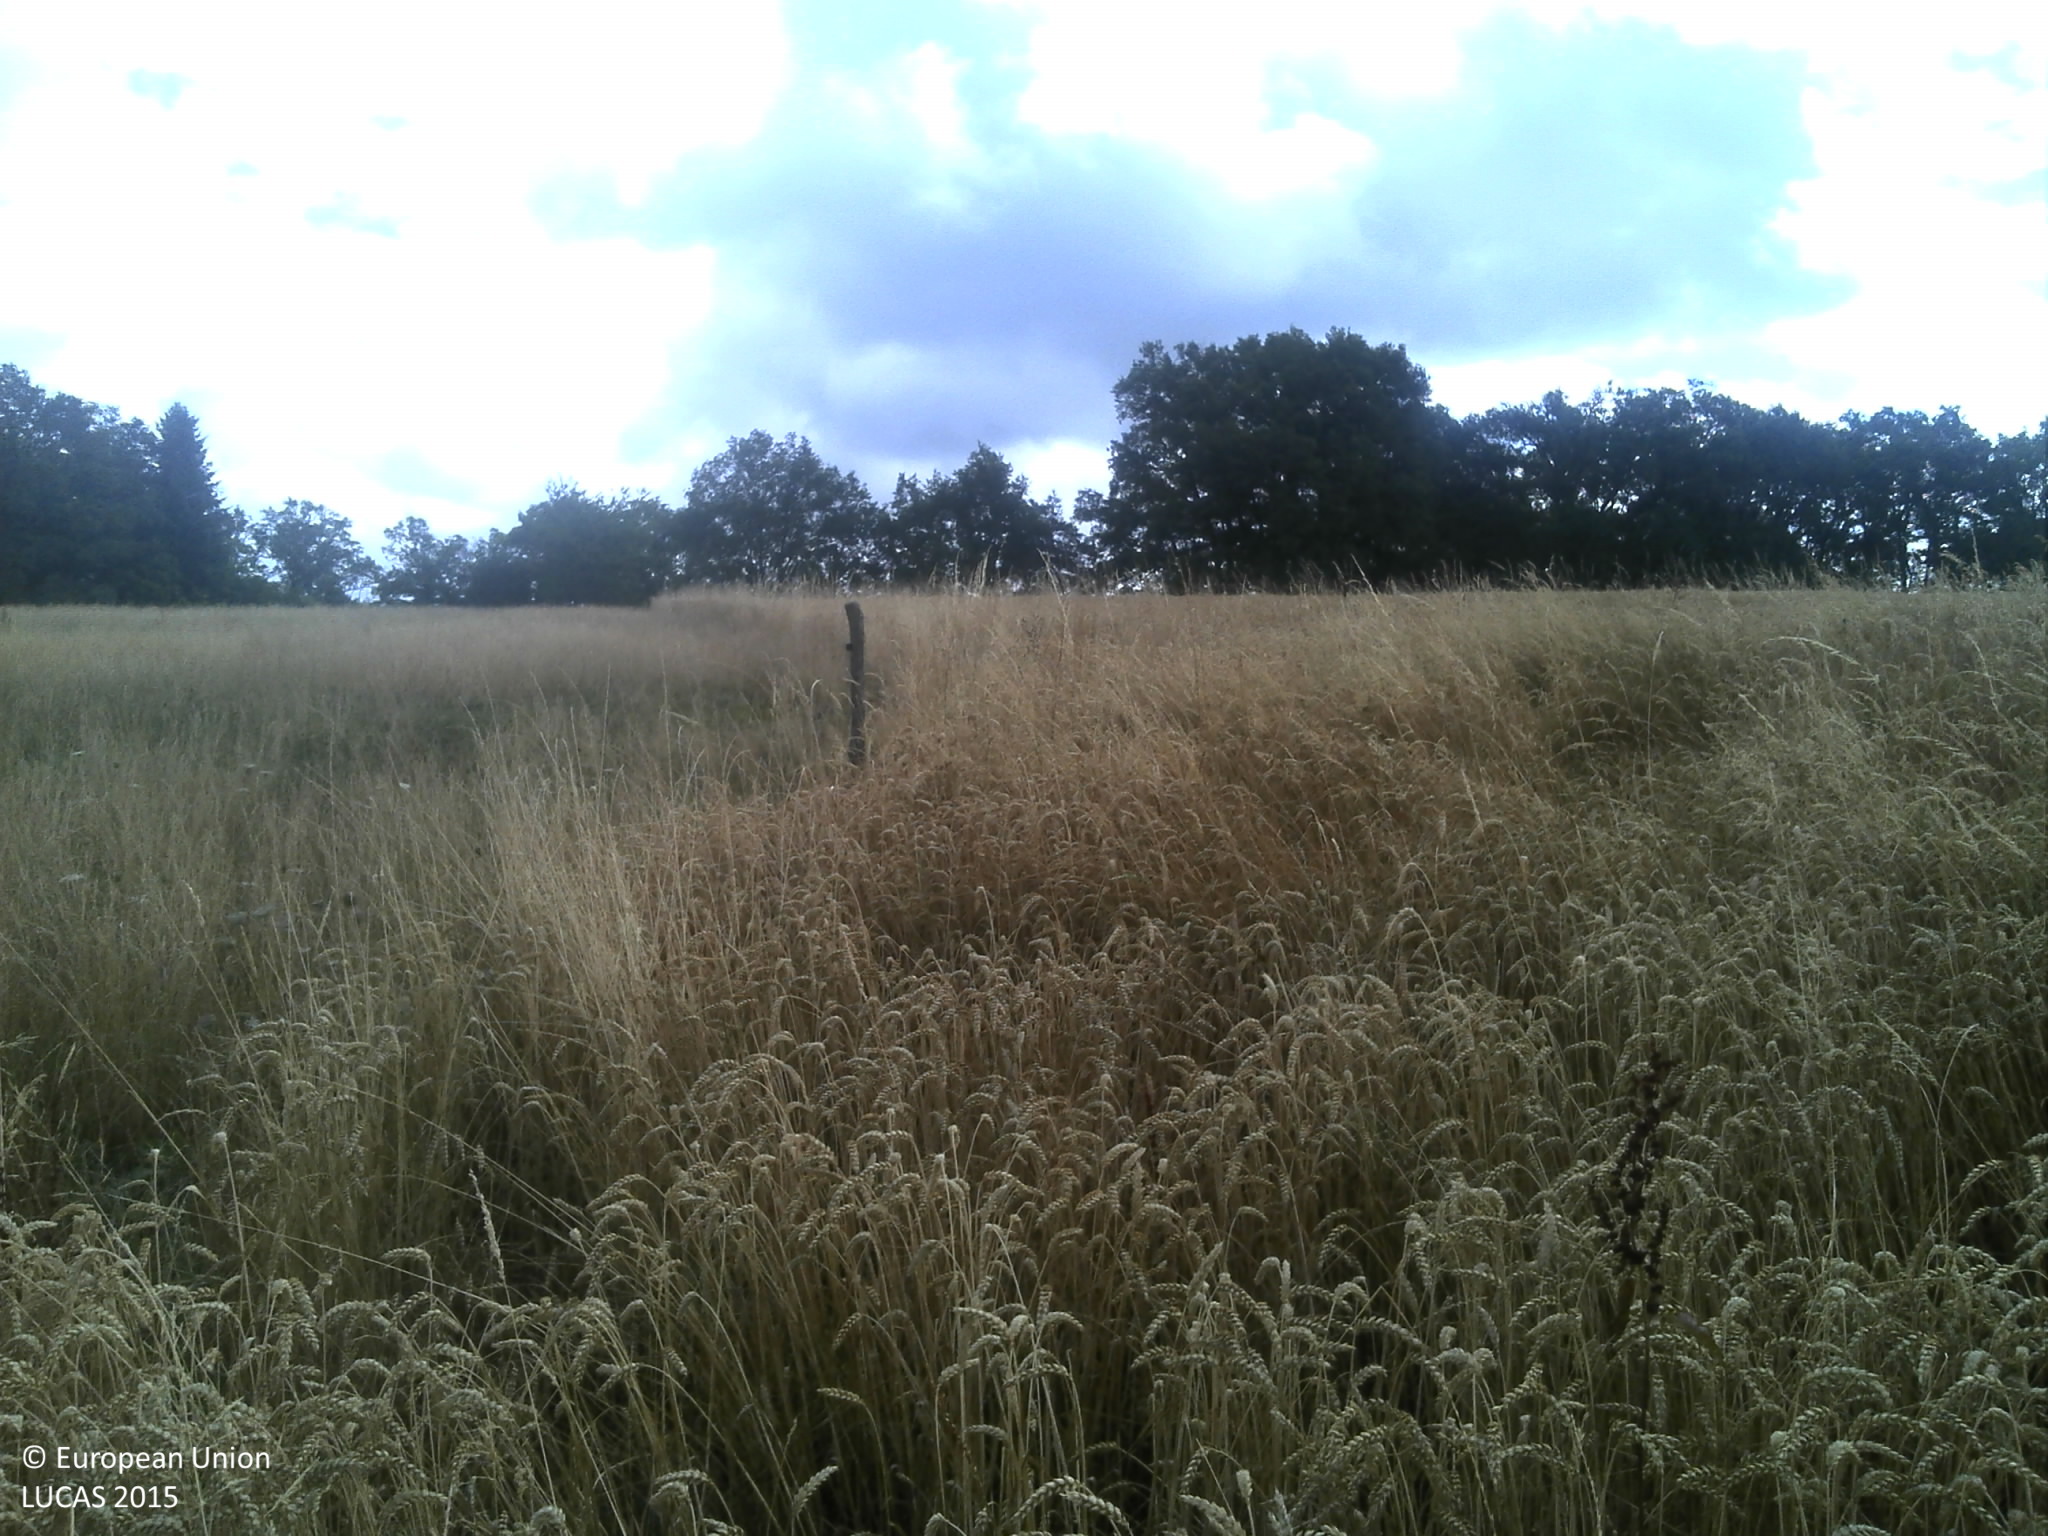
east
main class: Cropland
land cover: Common wheat
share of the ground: > 75 %
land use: Agriculture (excluding fallow land and kitchen gardens)
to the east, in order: Common wheat; Fences; Tracks; Fences; Abandoned hedges; Grassland without tree/shrub cover; Lines of trees; Grassland without tree/shrub cover
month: July
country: FR
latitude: 45.0507
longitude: 1.9352
